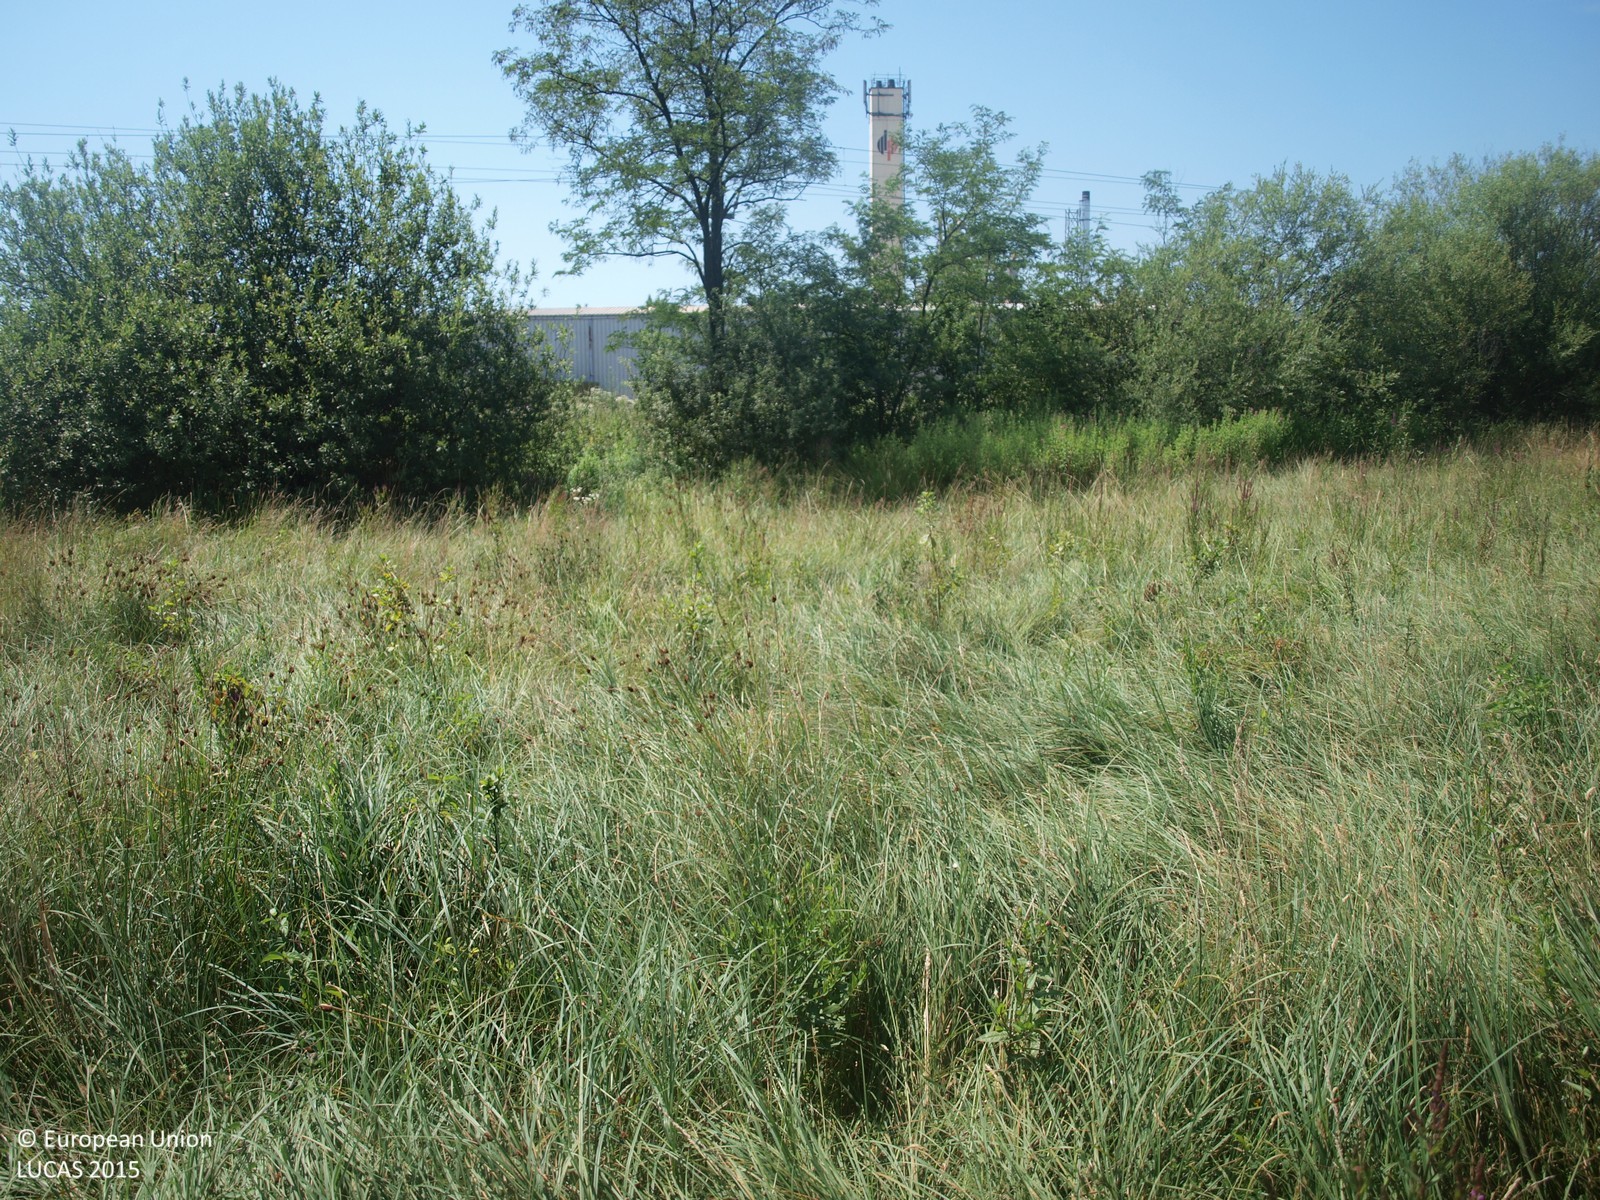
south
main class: Grassland
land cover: Grassland without tree/shrub cover
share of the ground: > 75 %
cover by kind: herbaceous plants 100 %
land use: Agriculture (excluding fallow land and kitchen gardens)
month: July
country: HR
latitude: 45.6598
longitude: 15.6567
